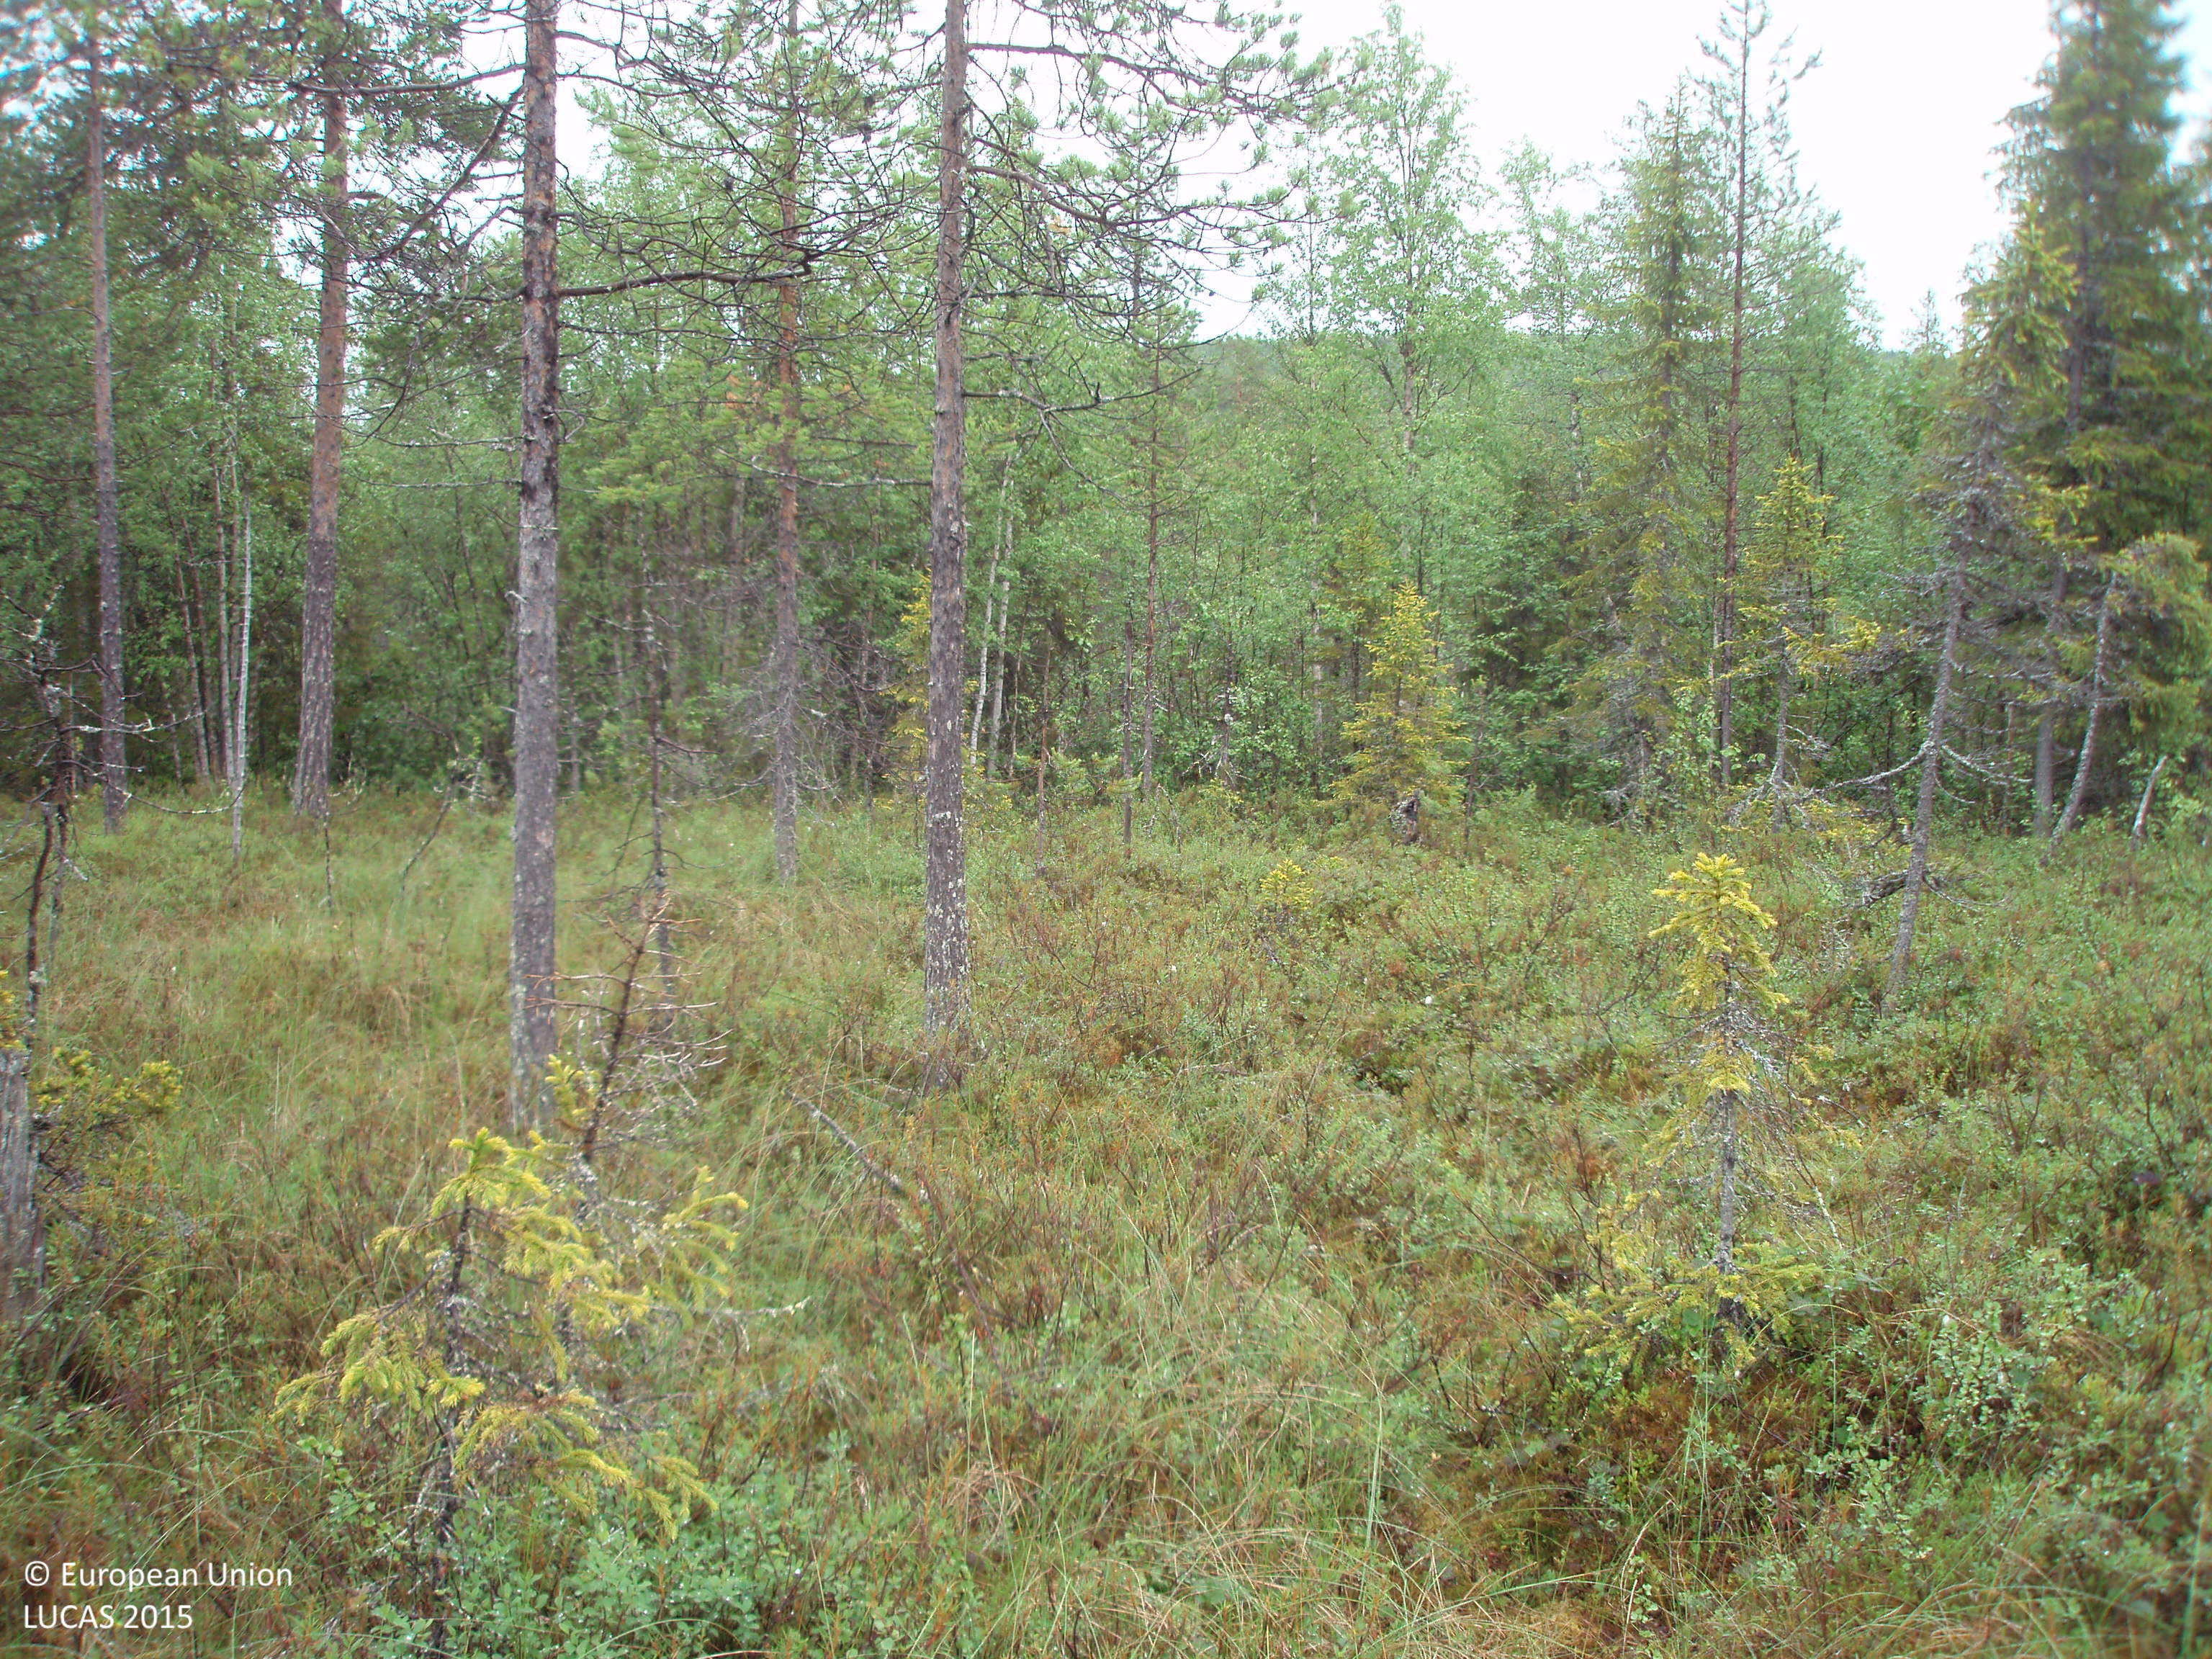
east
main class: Woodland
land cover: Pine dominated coniferous woodland
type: mire and swamp forests
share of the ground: 10 - 25 %
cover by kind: shrubs 70 %, coniferous forest trees 10 %, herbaceous plants 10 %, lichens and mosses 10 %
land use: Semi-natural and natural areas not in use
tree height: > 5 m
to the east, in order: Pine dominated coniferous woodland; Spruce dominated mixed woodland; Rivers and streams; Spruce dominated mixed woodland; Pine dominated mixed woodland; Pine dominated coniferous woodland; Peatbogs
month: July
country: FI
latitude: 66.7806
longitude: 27.9199
